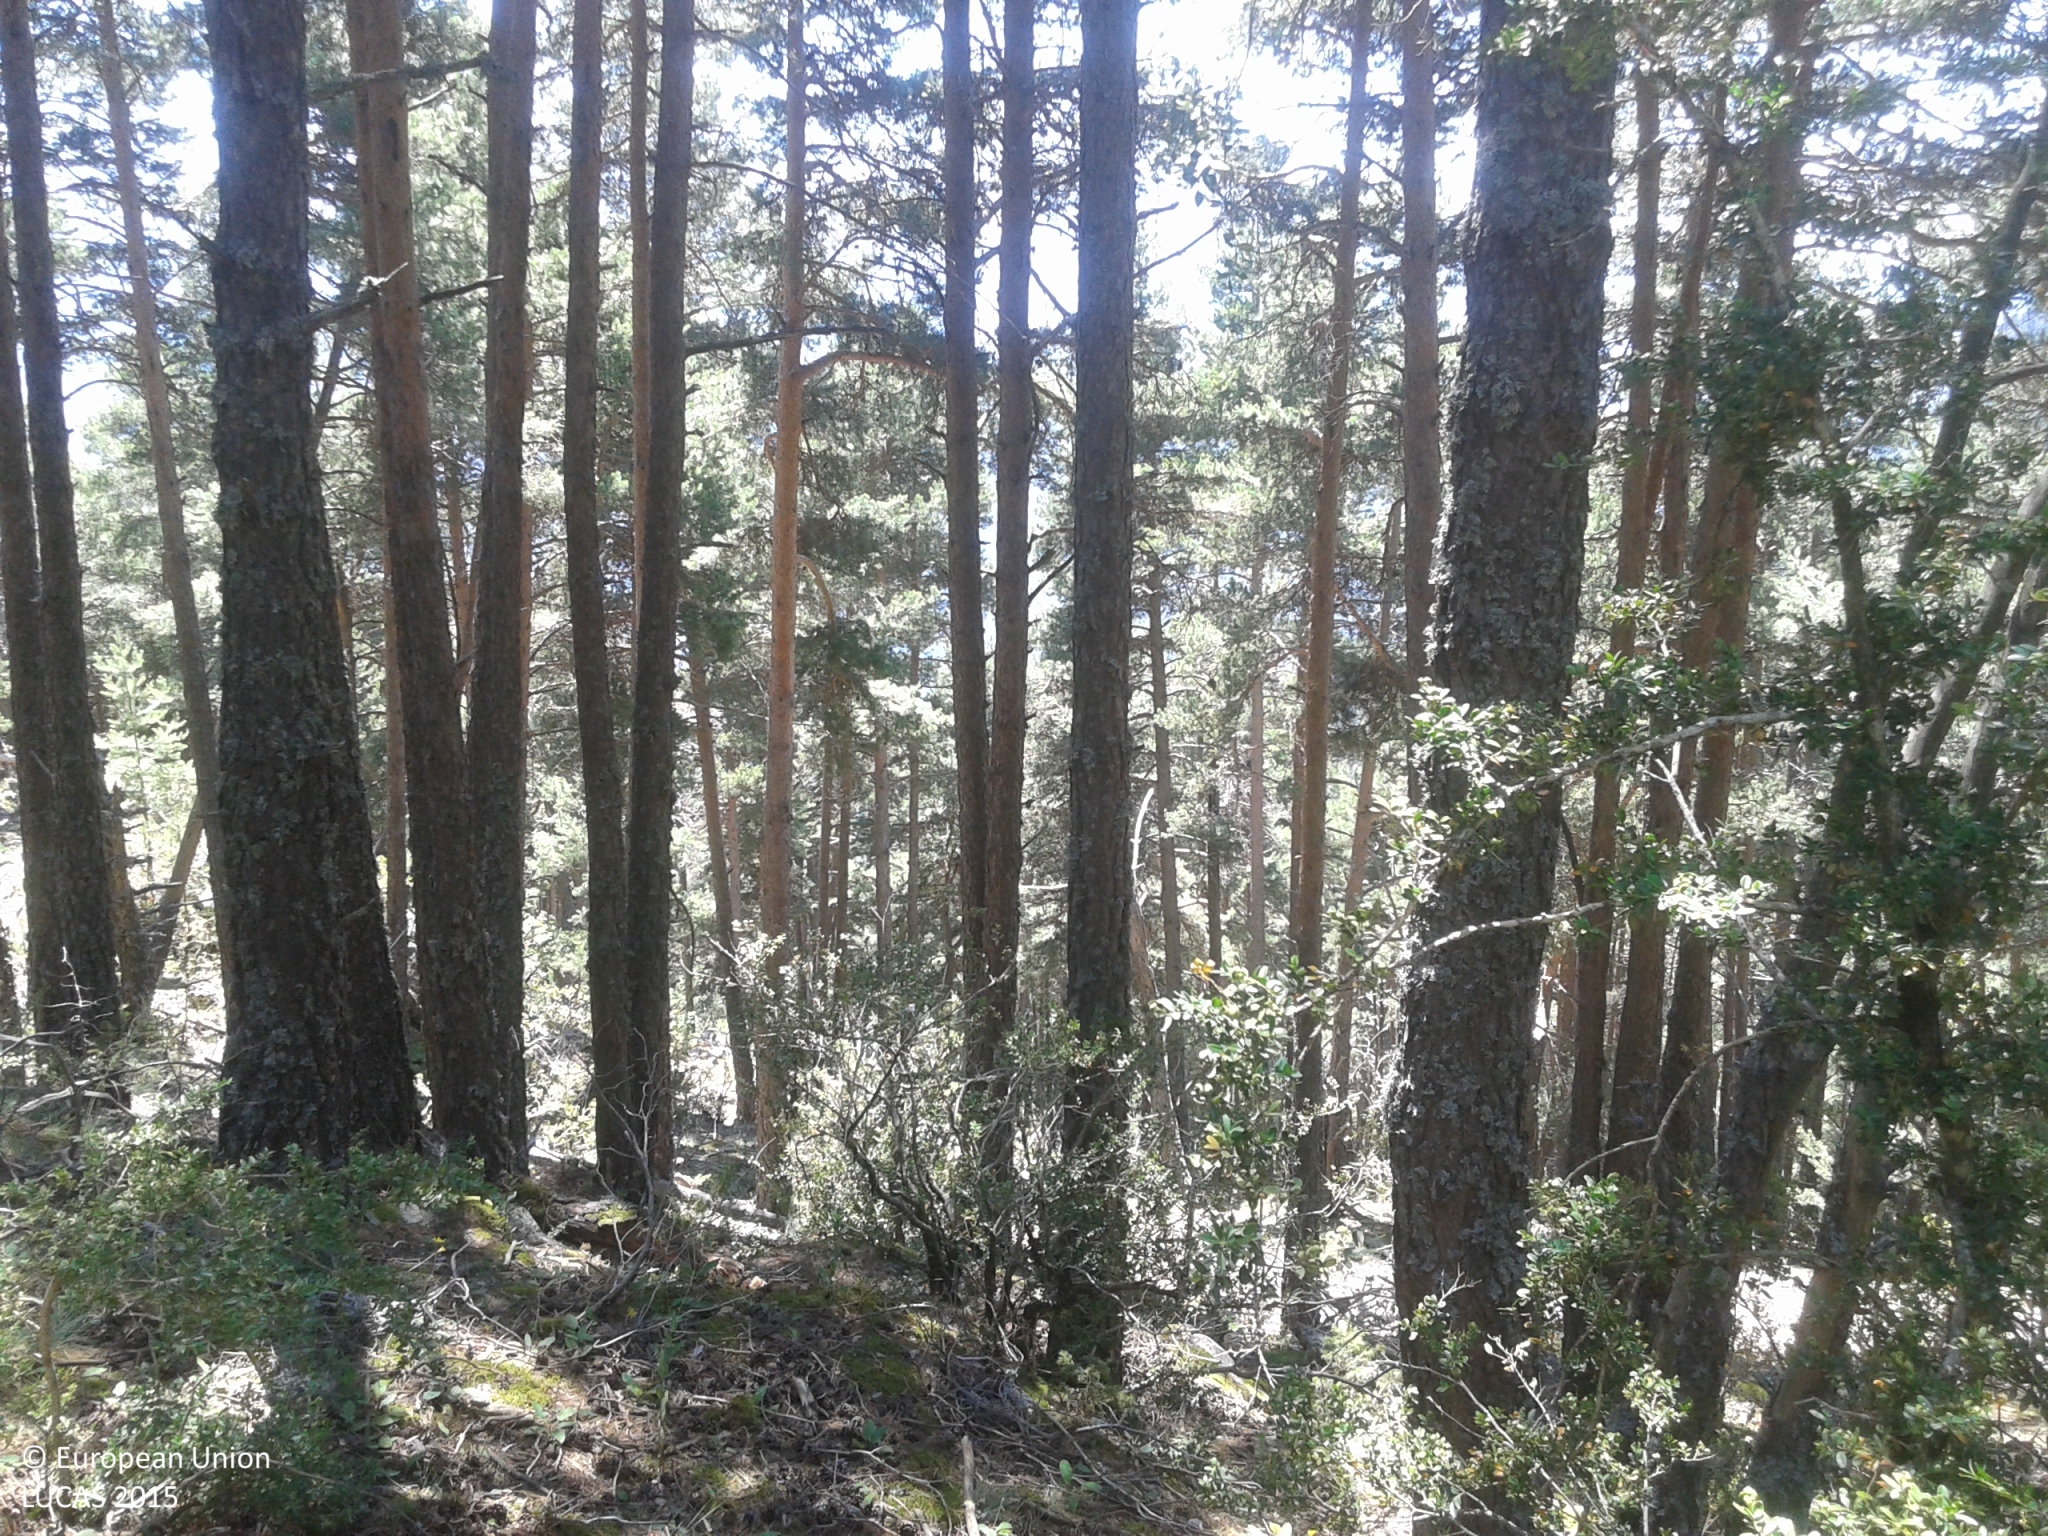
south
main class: Woodland
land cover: Pine dominated coniferous woodland
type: alpine coniferous forest
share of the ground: > 75 %
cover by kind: coniferous forest trees 85 %, lichens and mosses 10 %, shrubs 5 %
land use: Forestry
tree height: > 5 m
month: June
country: ES
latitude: 42.3967
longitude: 1.6157
